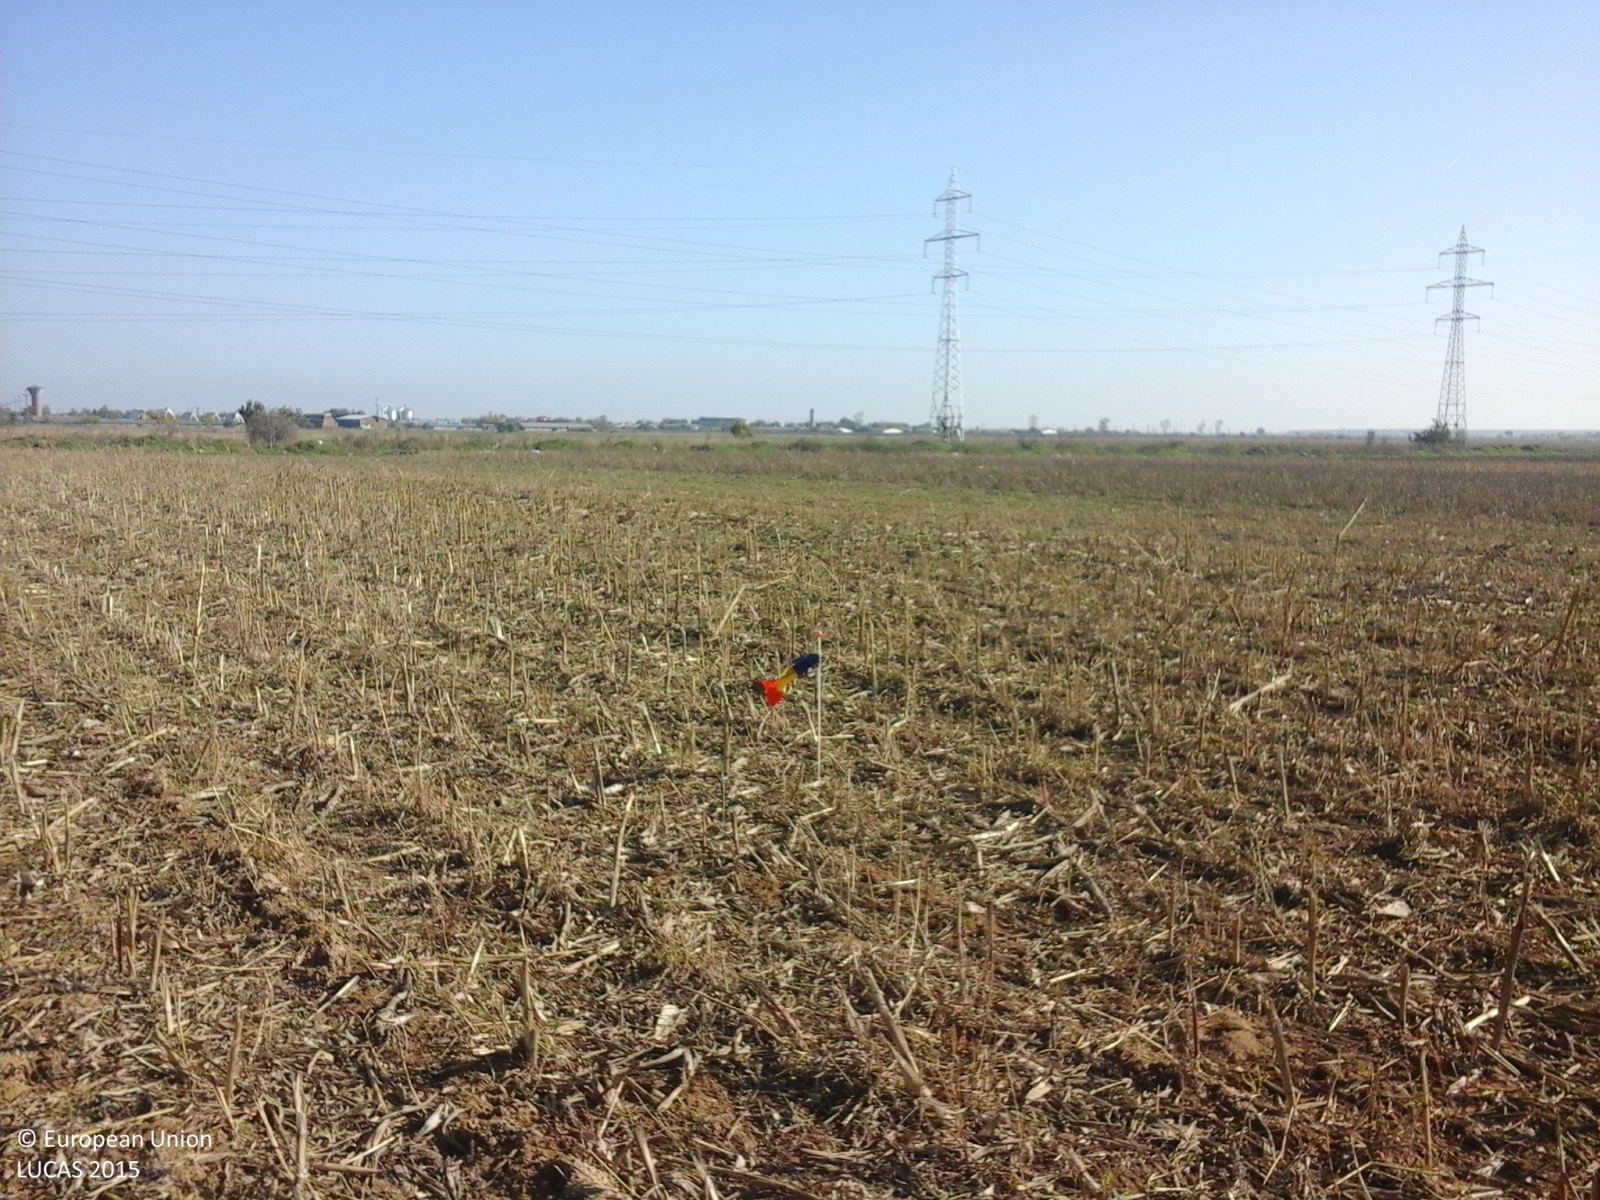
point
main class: Cropland
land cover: Maize
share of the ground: < 10 %
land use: Agriculture (excluding fallow land and kitchen gardens)
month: October
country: RO
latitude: 45.1332
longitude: 26.7214
